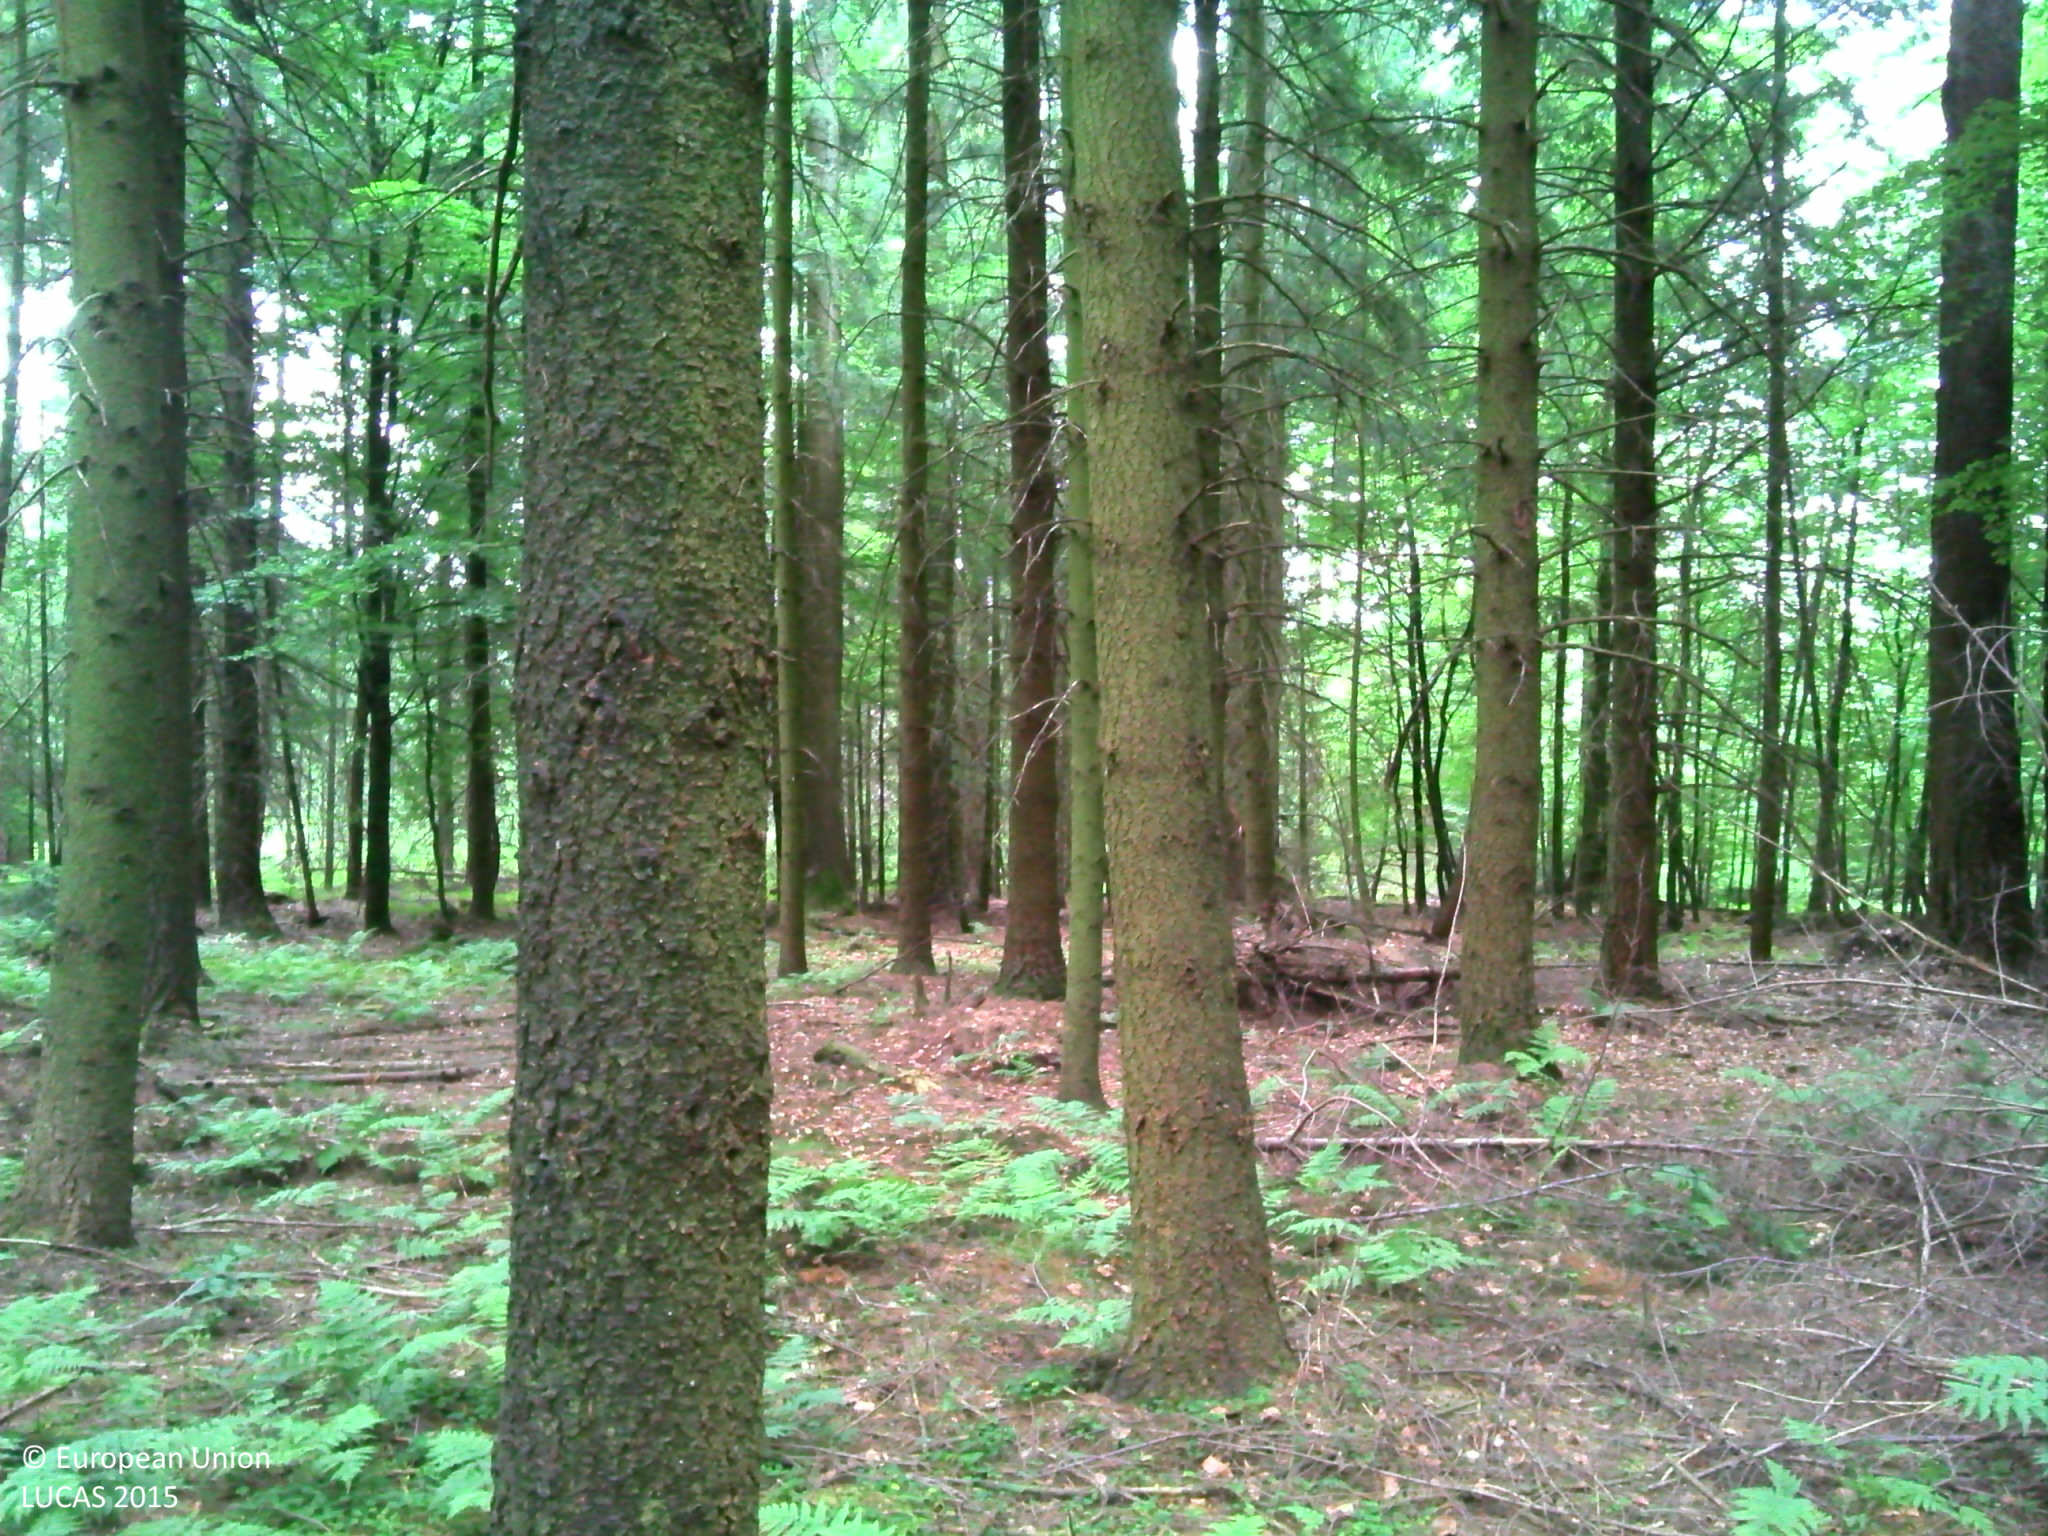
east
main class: Woodland
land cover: Other coniferous woodland
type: exotic forest
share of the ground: > 75 %
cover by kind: coniferous forest trees 95 %, herbaceous plants 5 %
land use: Forestry
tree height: > 5 m
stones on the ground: < 10 %
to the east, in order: Other coniferous woodland; Shrubland with sparse tree cover; Tracks; Spruce dominated coniferous woodland; Broadleaved woodland; Spruce dominated coniferous woodland
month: July
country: BE
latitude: 50.1963
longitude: 5.7822
